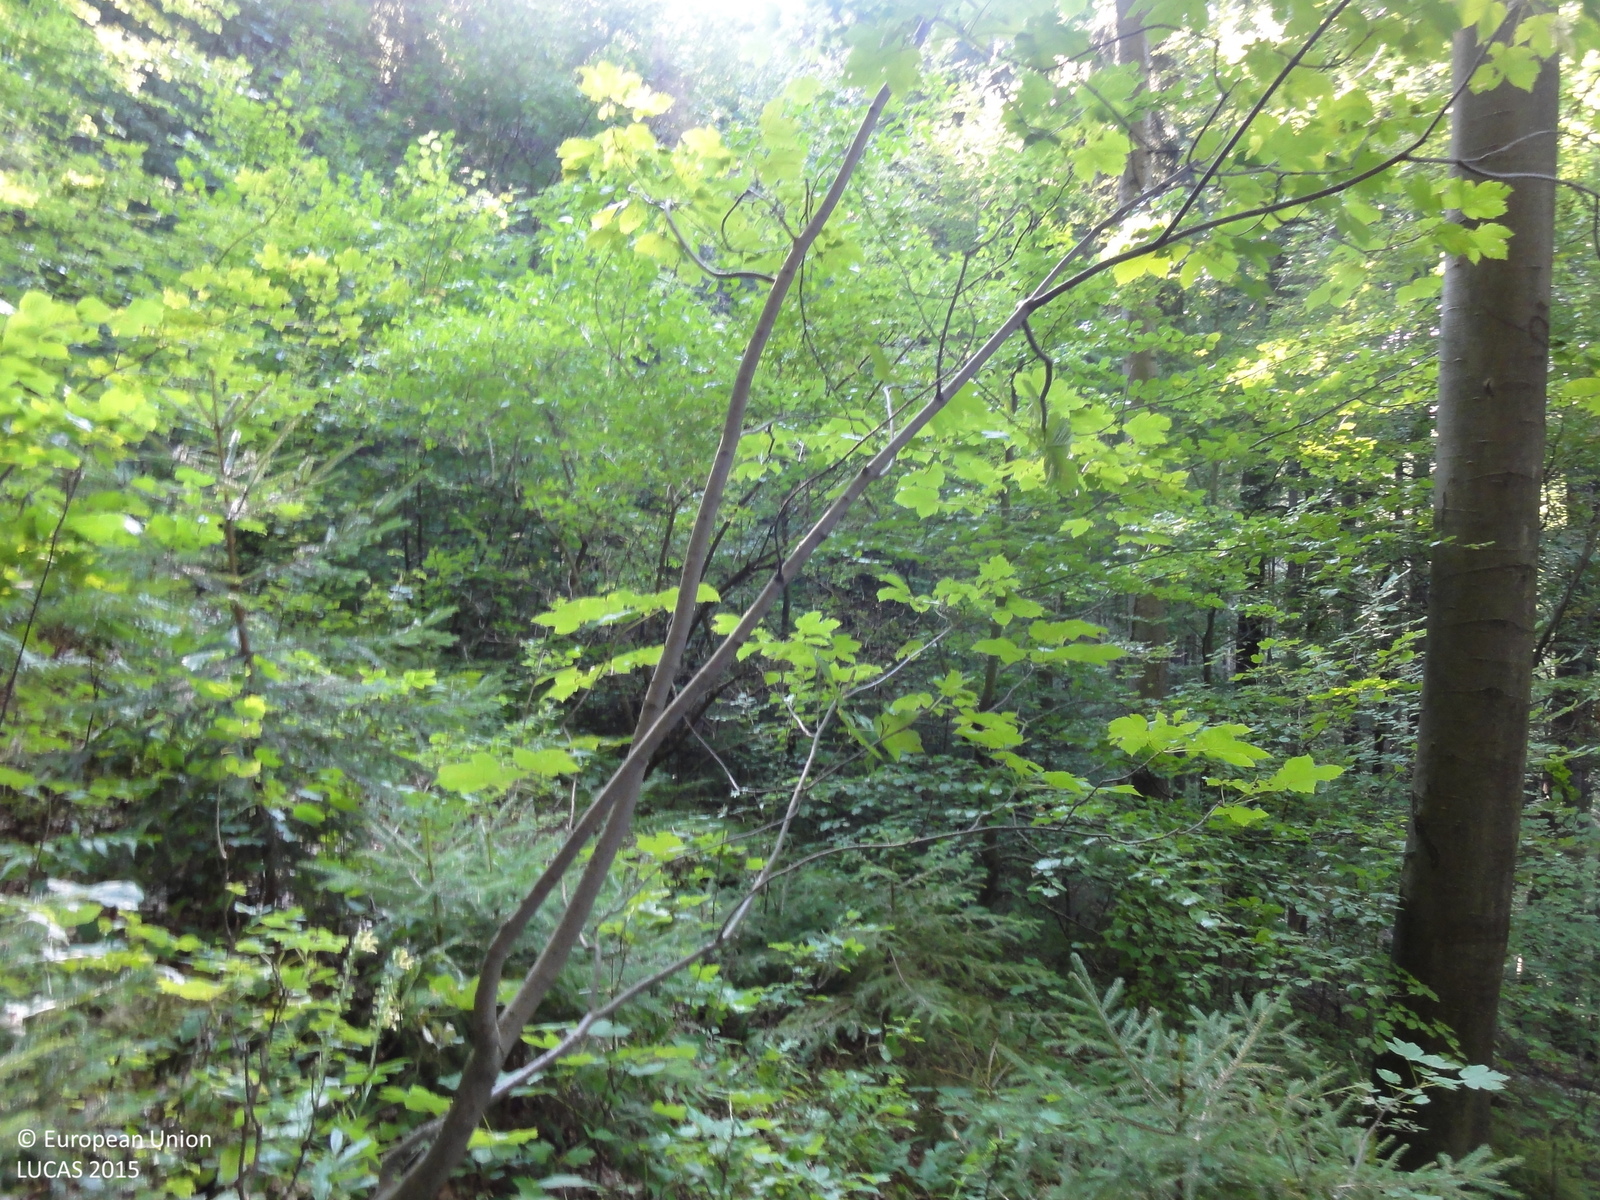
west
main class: Woodland
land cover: Broadleaved woodland
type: beech forest
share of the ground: > 75 %
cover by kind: broadleaved forest trees 90 %, coniferous forest trees 10 %
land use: Forestry
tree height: > 5 m
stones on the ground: 10 - 25 %
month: August
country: SI
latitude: 46.1041
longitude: 15.0813
